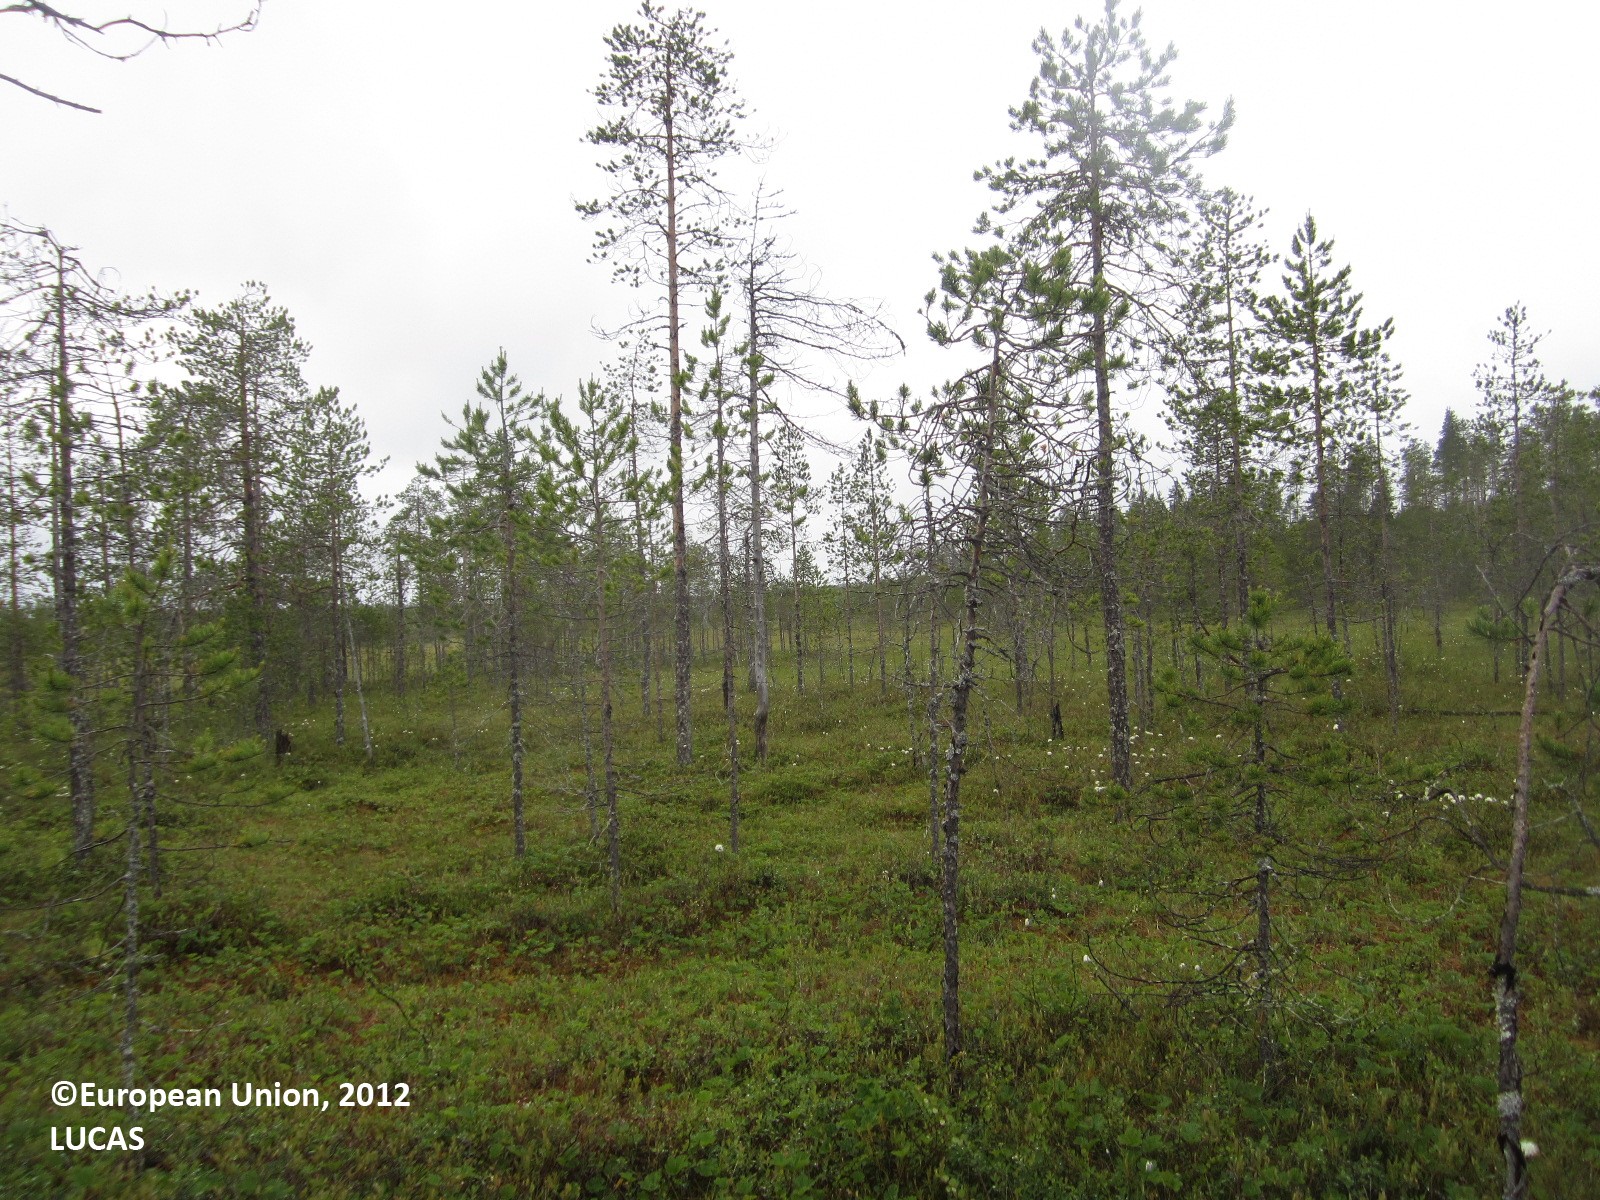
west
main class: Woodland
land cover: Pine dominated coniferous woodland
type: boreal forest
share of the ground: 10 - 25 %
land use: Forestry
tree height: > 5 m
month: June
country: FI
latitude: 64.4987
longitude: 29.9458
